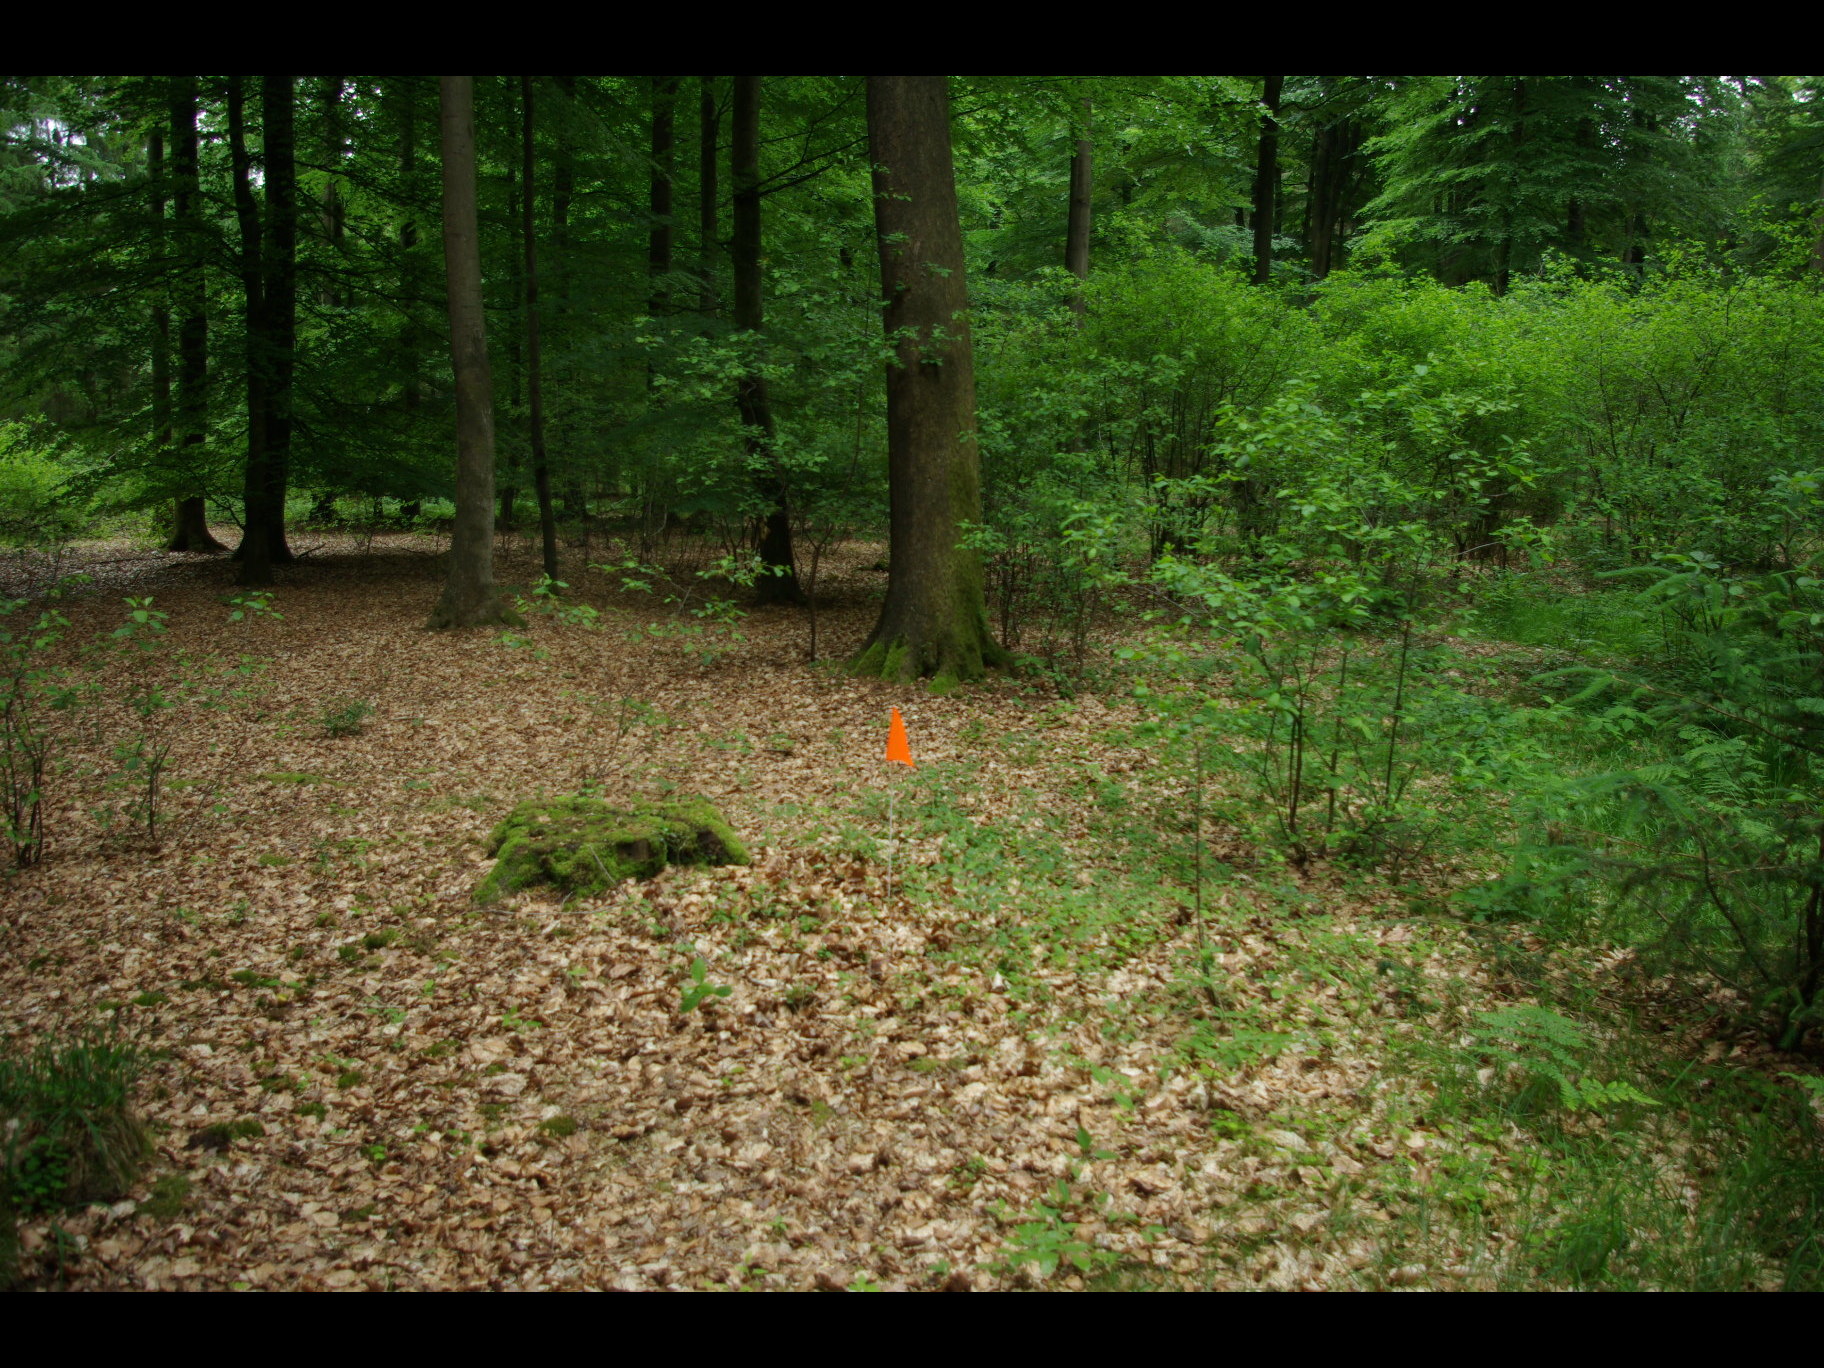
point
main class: Woodland
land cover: Broadleaved woodland
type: beech forest
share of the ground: > 75 %
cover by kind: broadleaved forest trees 80 %, unconsolidated bare surface 10 %, shrubs 5 %, herbaceous plants 5 %
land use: Forestry
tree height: > 5 m
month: June
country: DE
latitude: 54.0664
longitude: 9.6488
